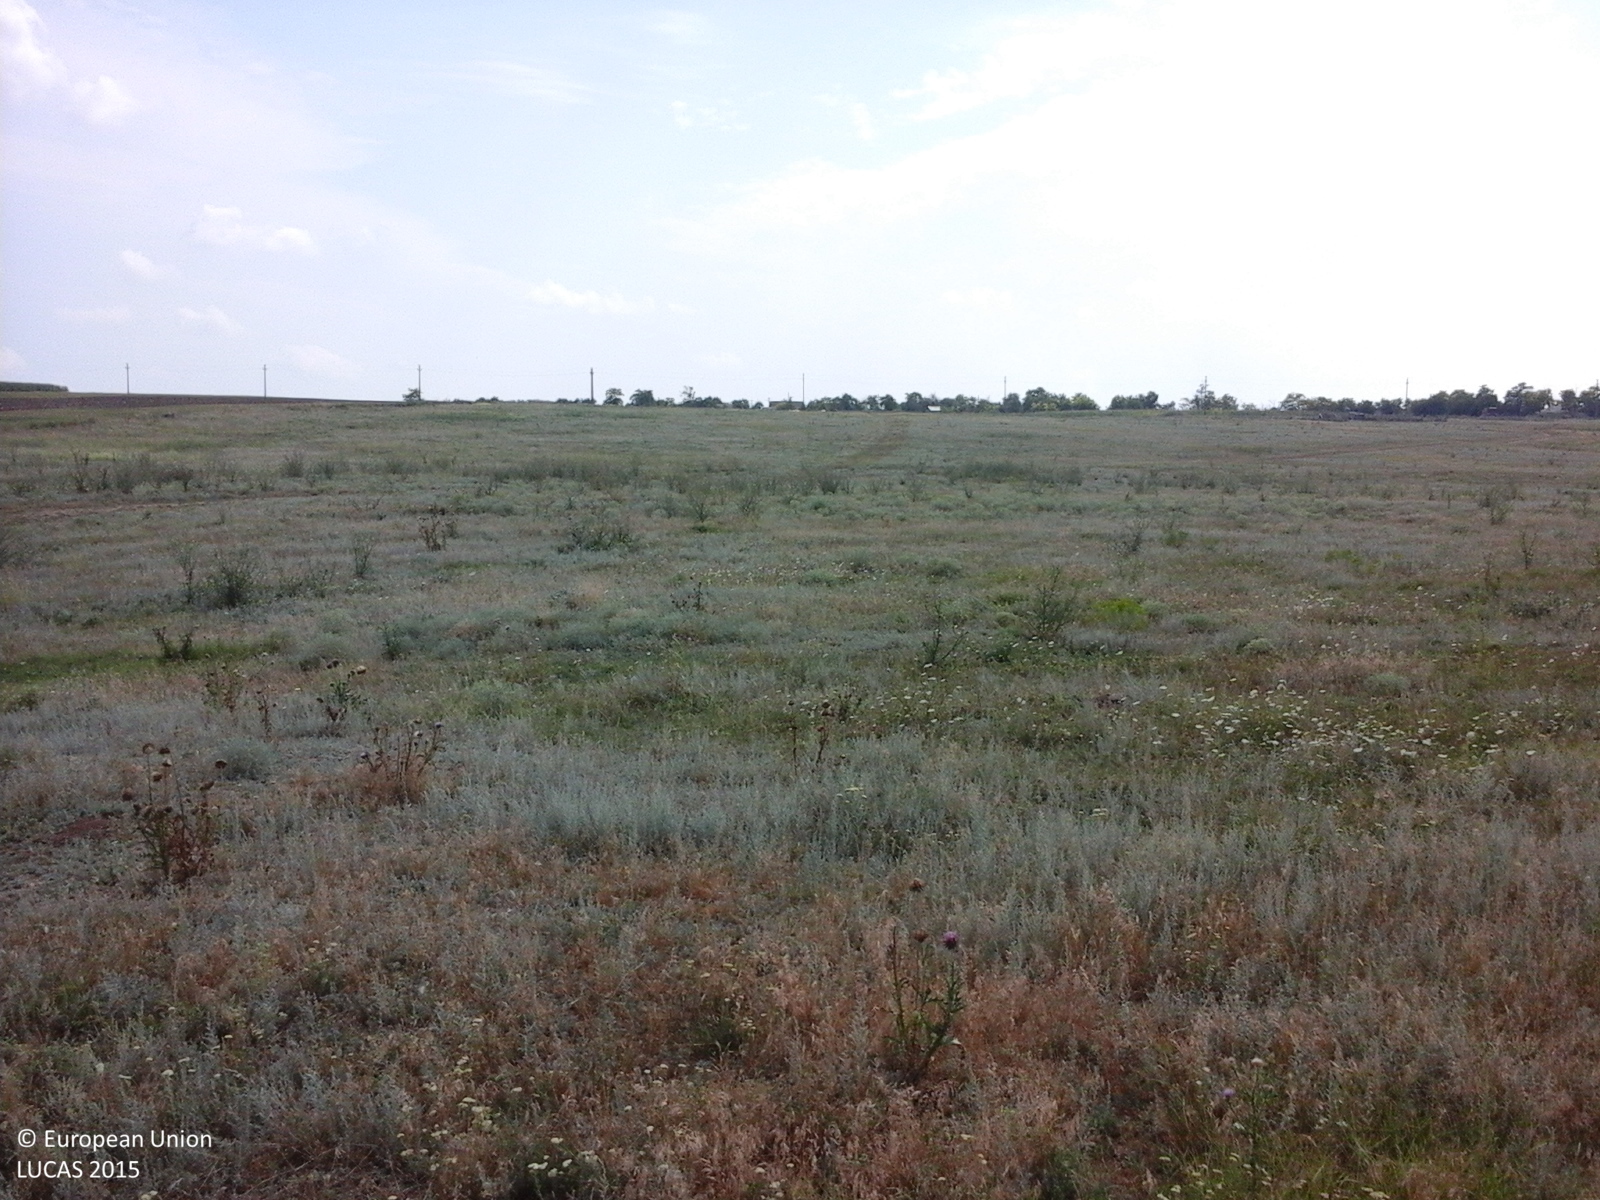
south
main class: Grassland
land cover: Spontaneously vegetated surfaces
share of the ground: > 75 %
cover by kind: herbaceous plants 100 %
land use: Agriculture (excluding fallow land and kitchen gardens)
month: July
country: RO
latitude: 44.8685
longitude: 28.2831
